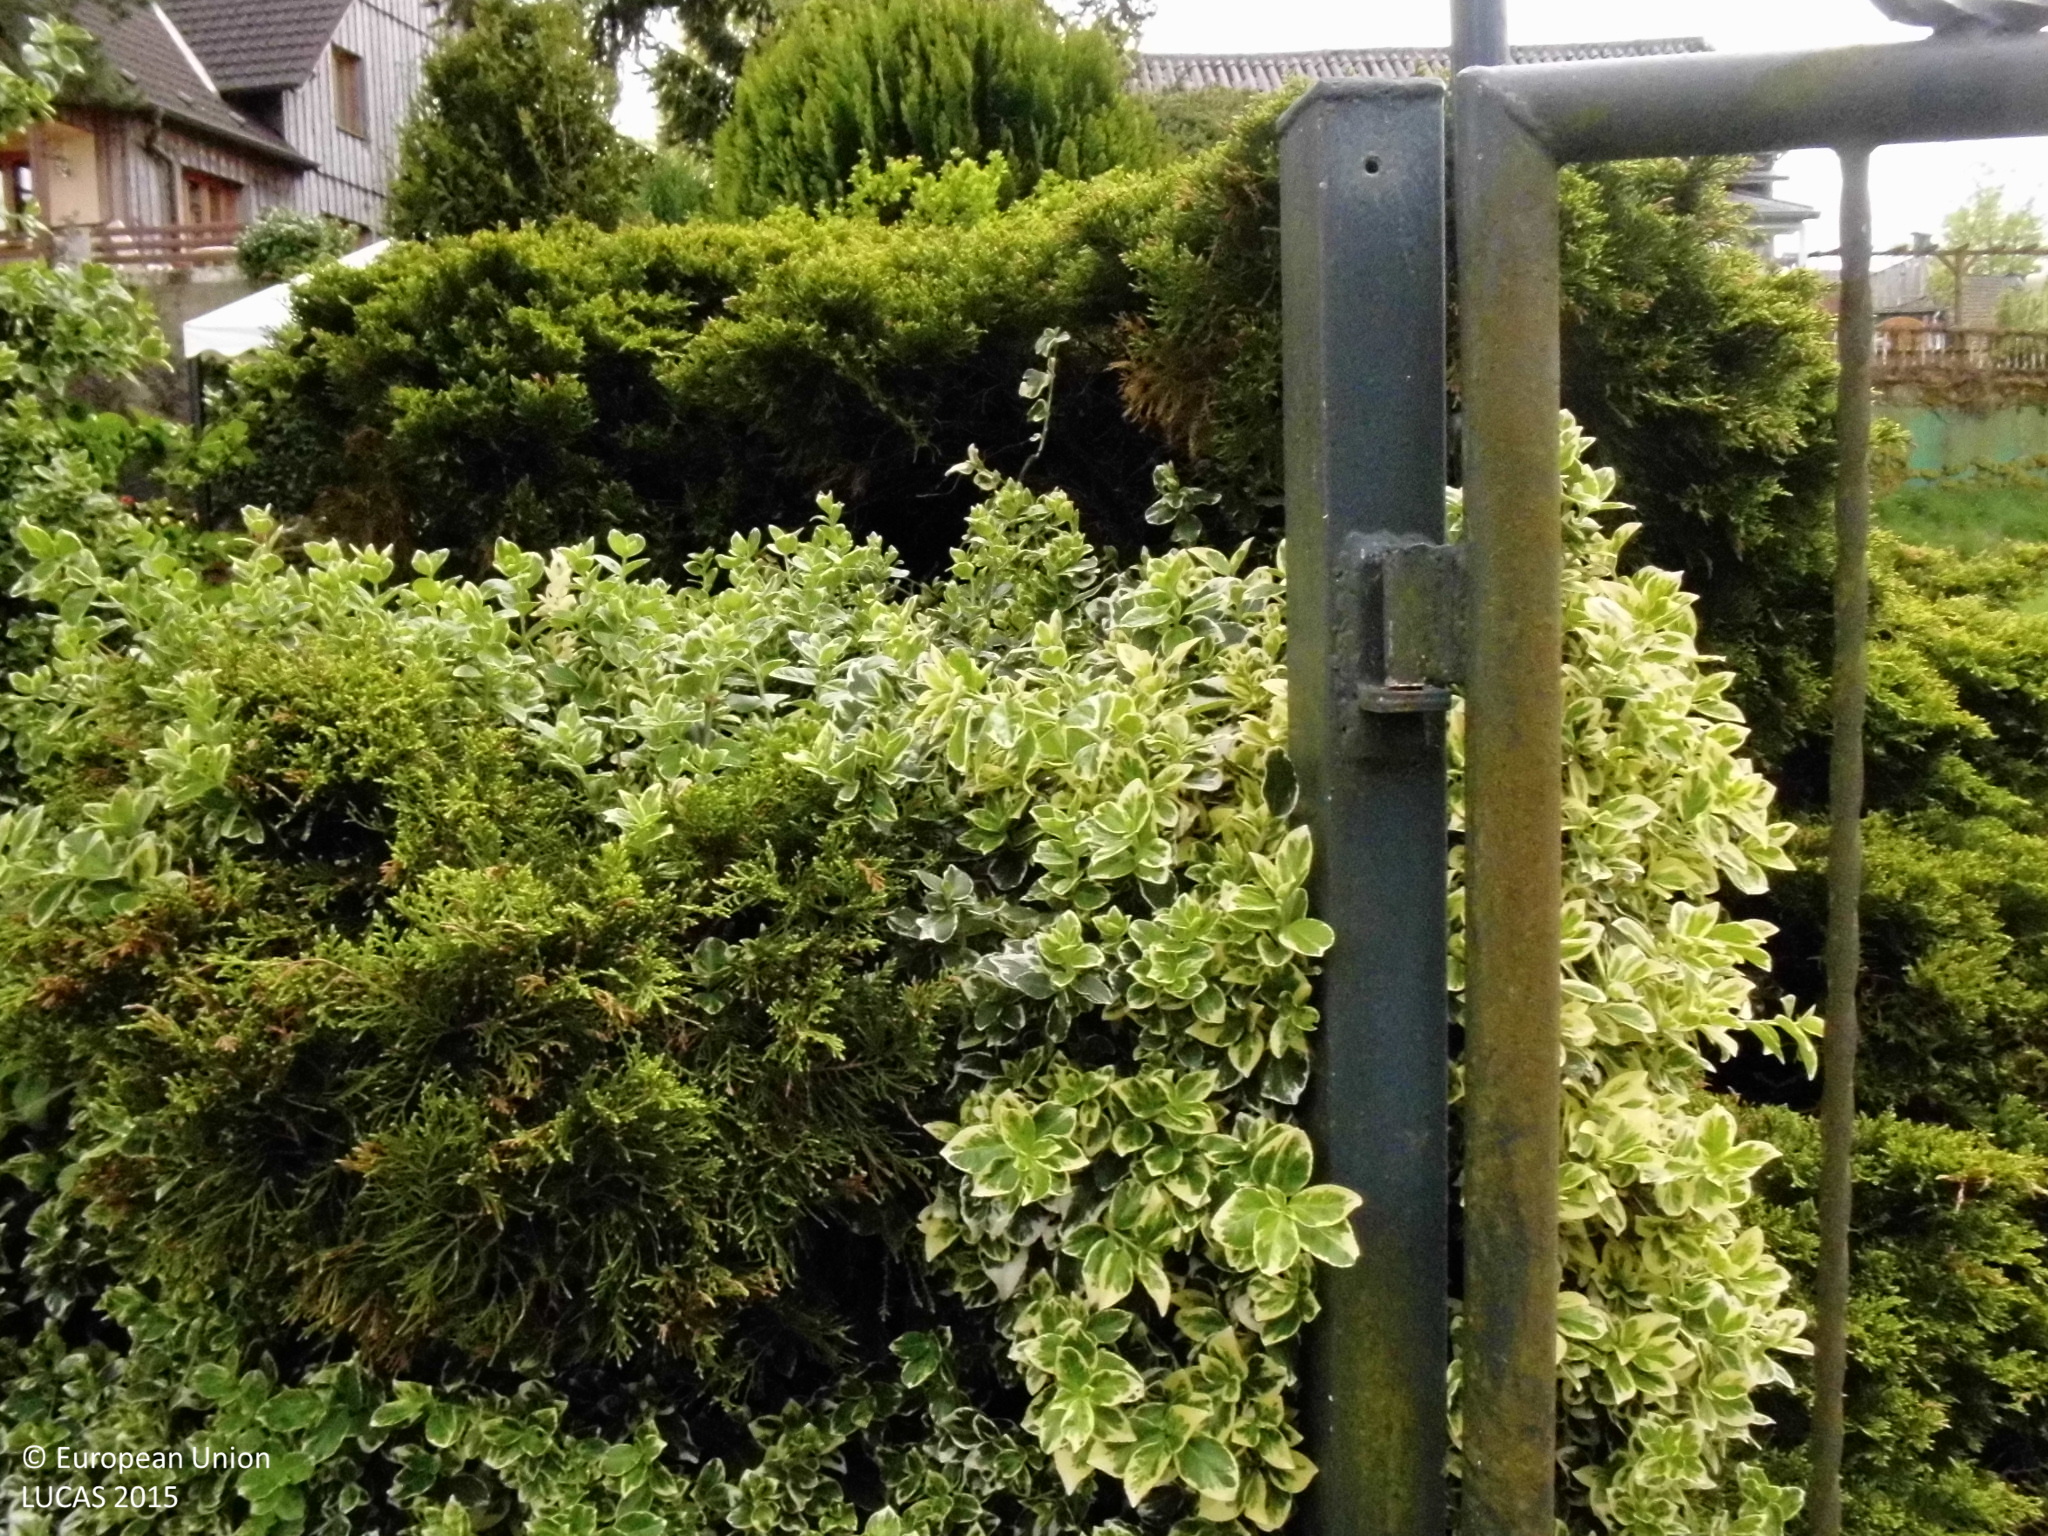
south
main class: Grassland
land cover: Grassland without tree/shrub cover
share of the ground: > 75 %
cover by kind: herbaceous plants 100 %
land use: Residential
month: May
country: DE
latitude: 51.2707
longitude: 7.4345
